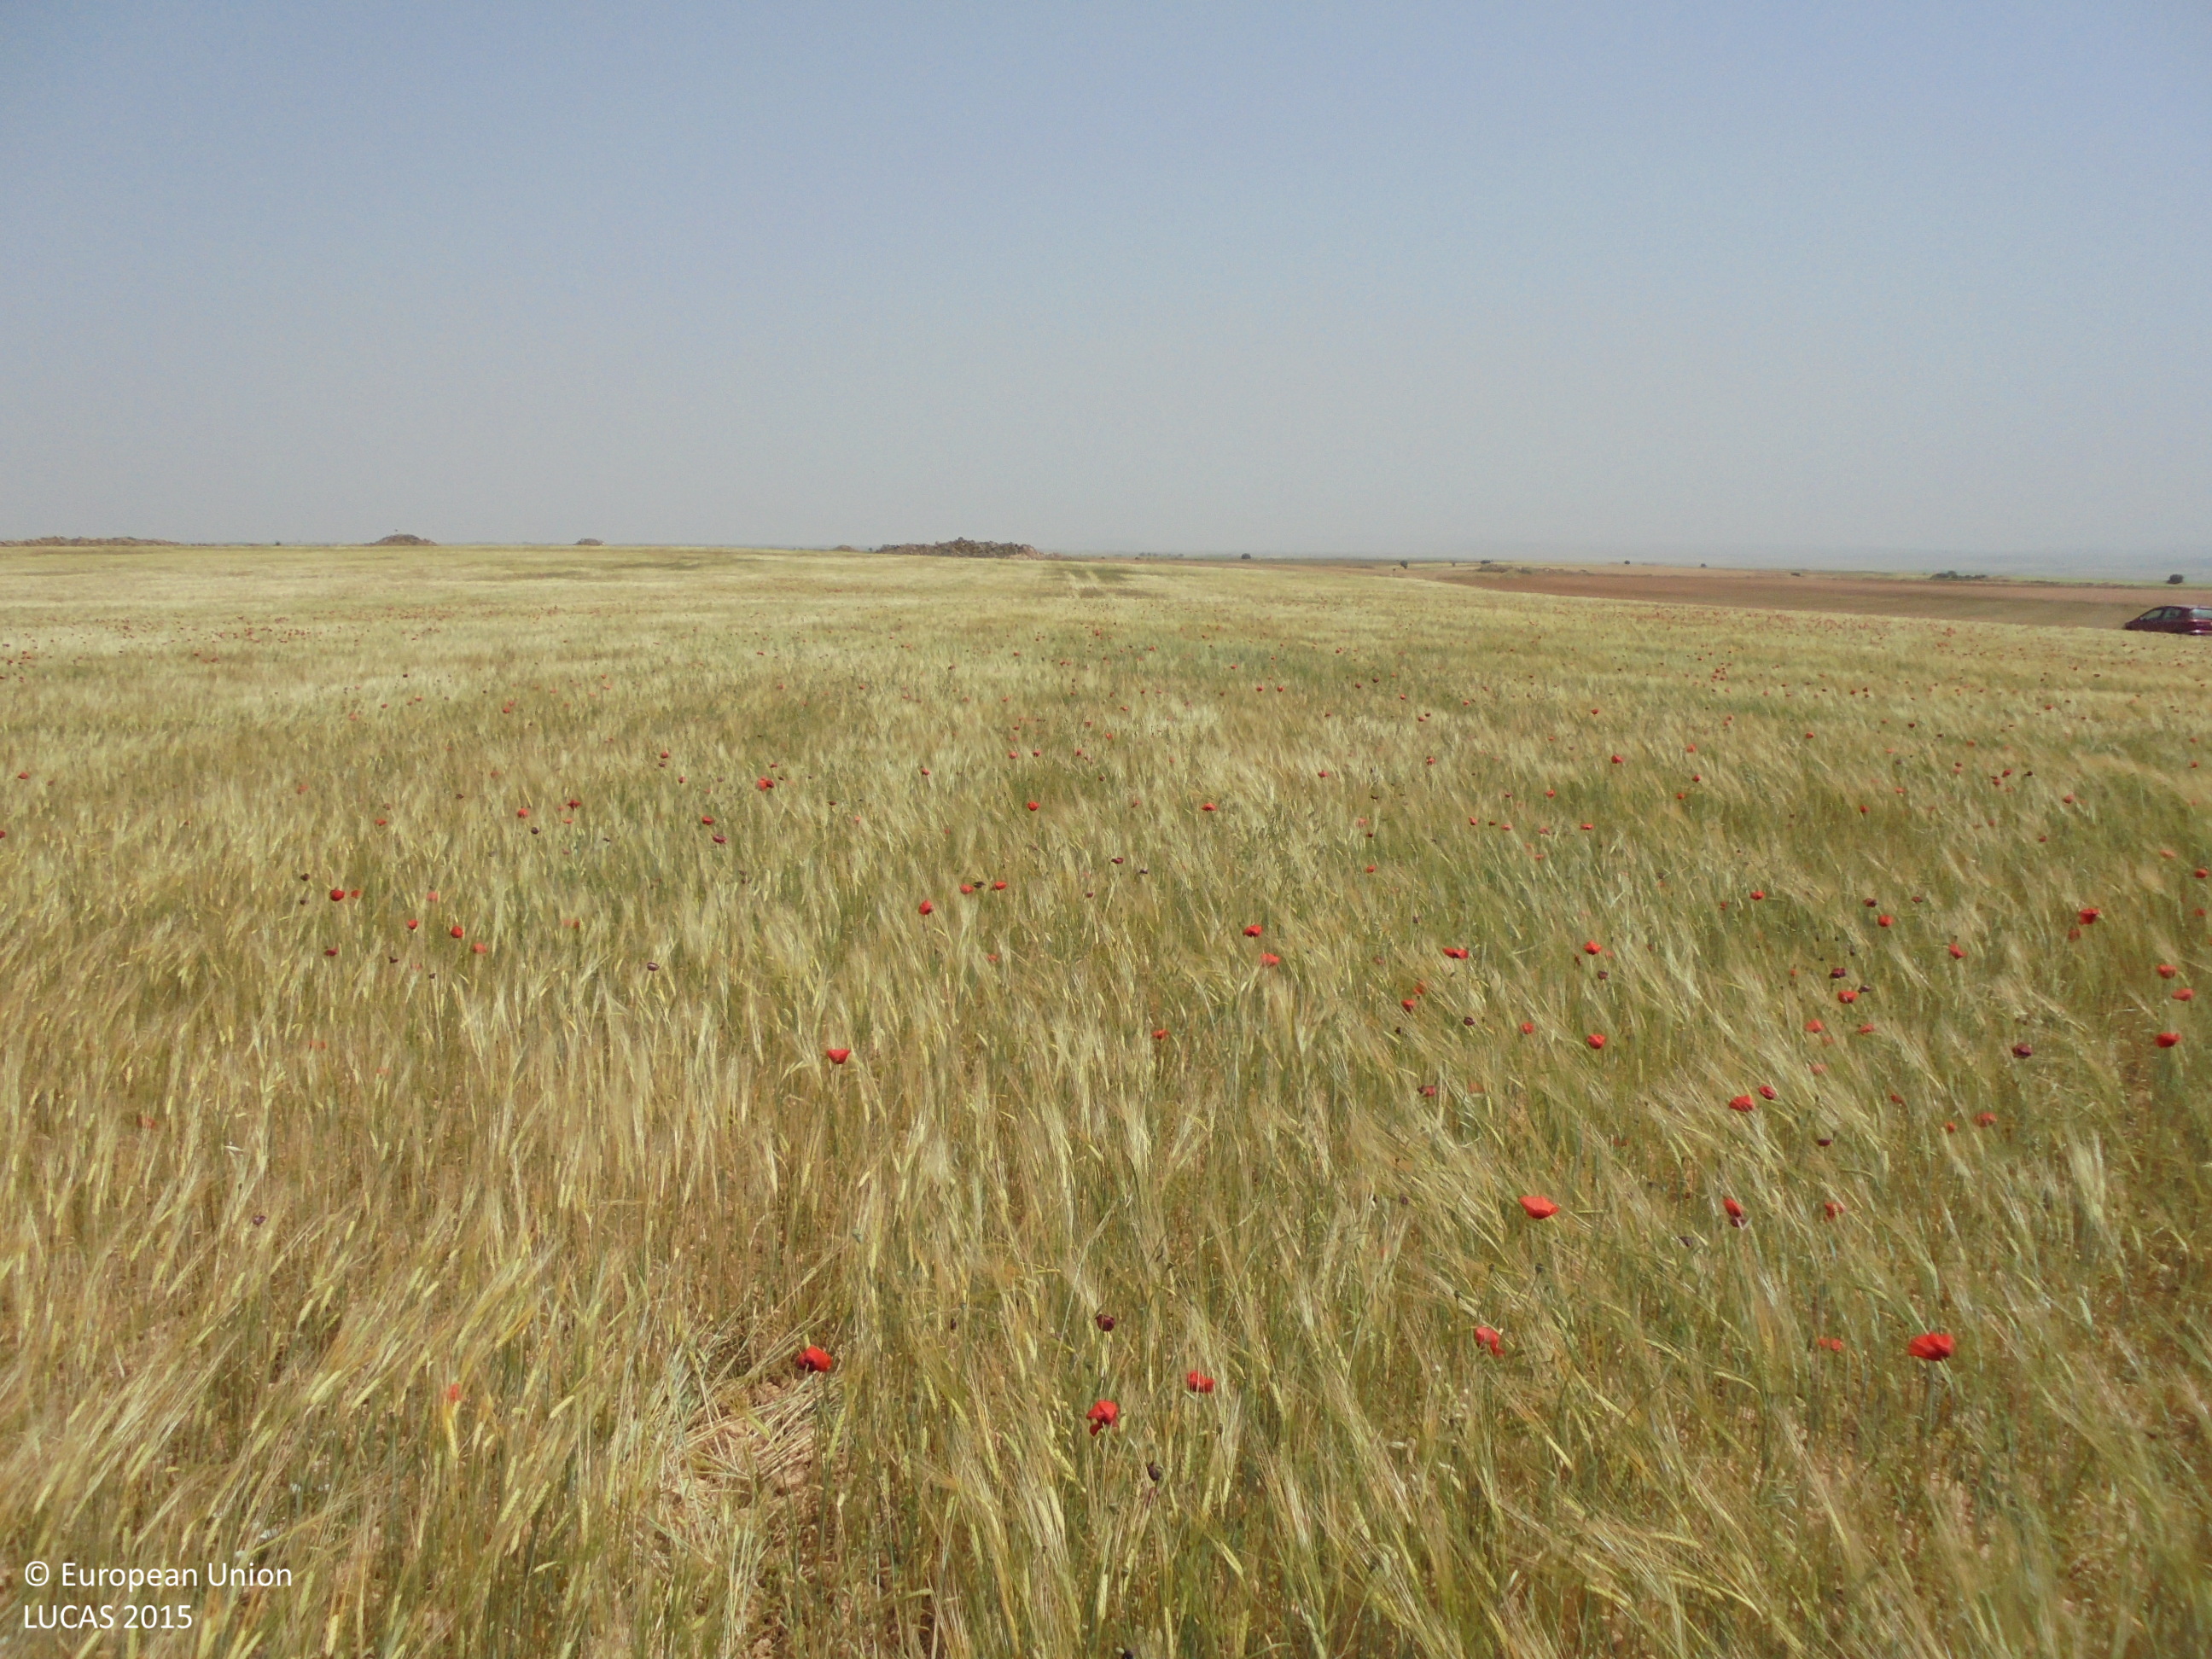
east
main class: Cropland
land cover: Barley
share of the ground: 50 - 75 %
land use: Agriculture (excluding fallow land and kitchen gardens)
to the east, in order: Barley; Grass margins; Dry stone walls; Grass margins; Other bare soil
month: May
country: ES
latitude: 39.1061
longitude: -1.7151
